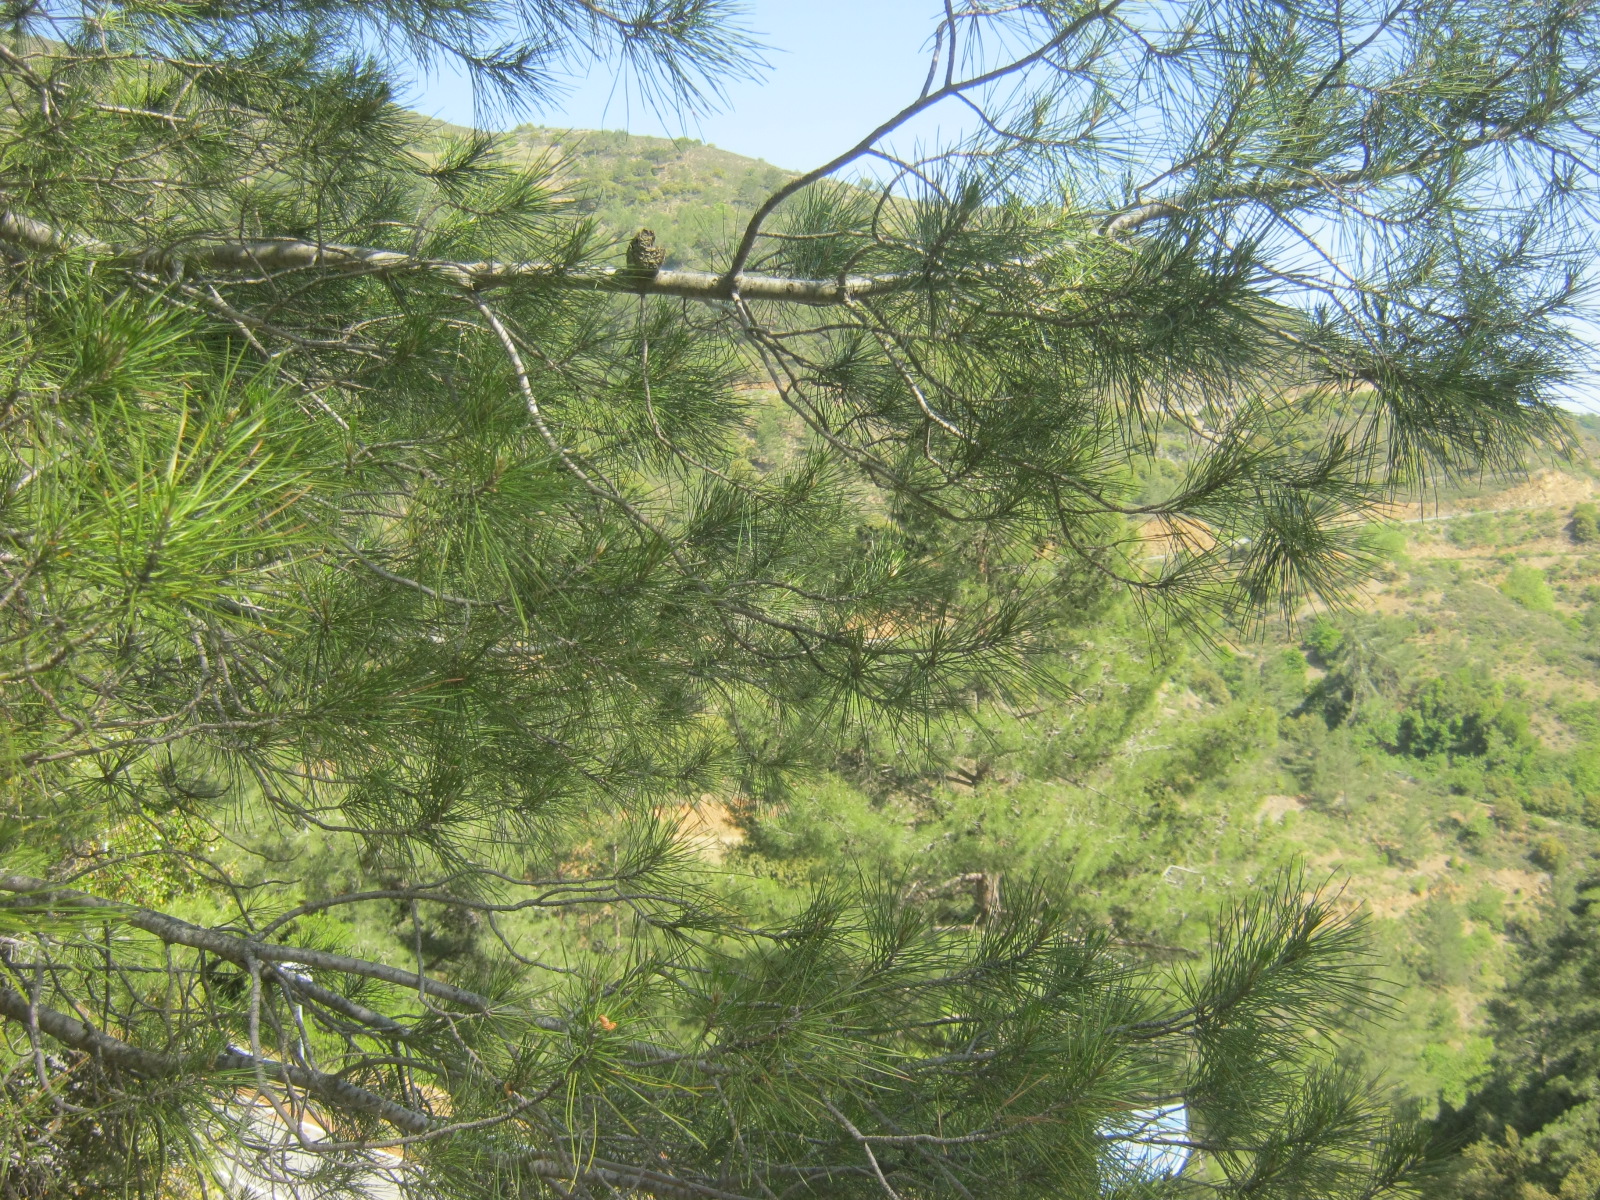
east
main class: Woodland
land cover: Pine dominated coniferous woodland
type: coniferous forest of the mediterranean region
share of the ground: 50 - 75 %
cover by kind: coniferous forest trees 50 %, unconsolidated bare surface 20 %, herbaceous plants 15 %, shrubs 10 %, broadleaved forest trees 5 %
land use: Semi-natural and natural areas not in use
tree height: > 5 m
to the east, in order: Pine dominated coniferous woodland; Paved roads, cycling and walking lanes; Pine dominated coniferous woodland; Tracks; Broadleaved woodland; Shrubland with sparse tree cover; Paved roads, cycling and walking lanes; Shrubland with sparse tree cover
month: May
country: CY
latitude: 34.9572
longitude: 32.8006
